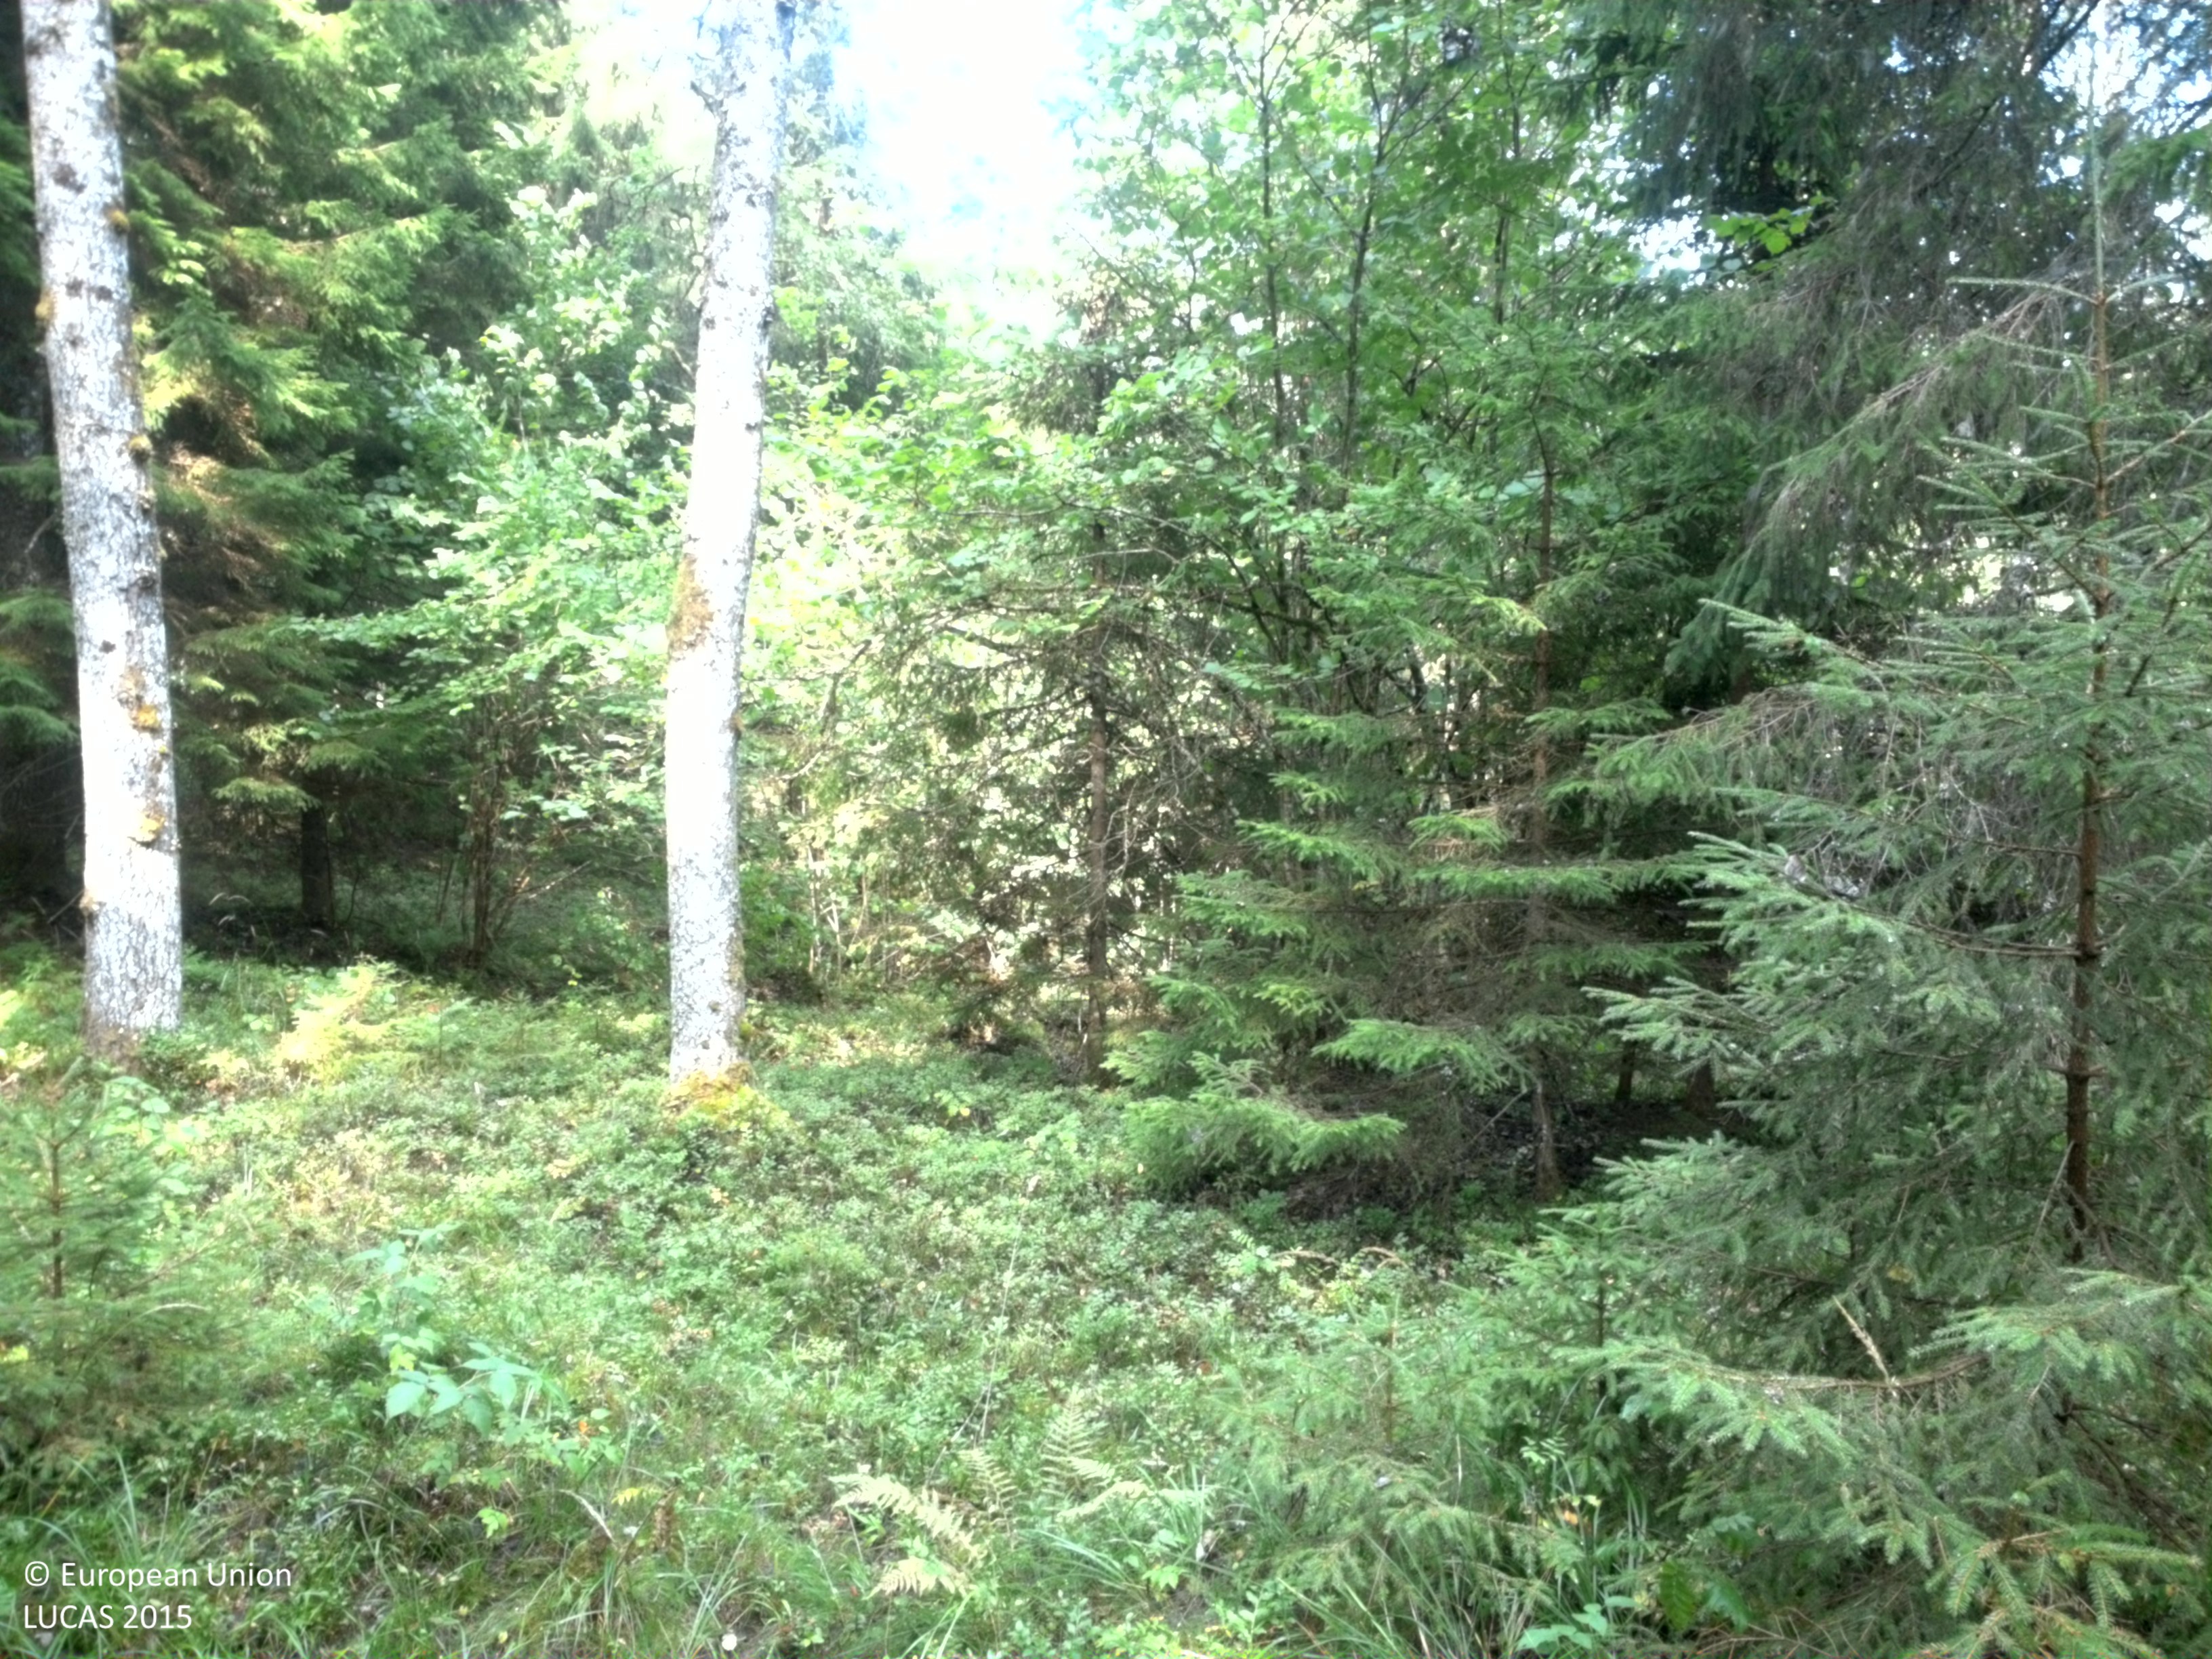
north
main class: Woodland
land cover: Spruce dominated mixed woodland
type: boreal forest
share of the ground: 25 - 50 %
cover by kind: coniferous forest trees 25 %, broadleaved forest trees 25 %, herbaceous plants 20 %, lichens and mosses 20 %, shrubs 10 %
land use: Agriculture (excluding fallow land and kitchen gardens)
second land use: Forestry
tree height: > 5 m
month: August
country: SE
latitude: 57.9450
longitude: 13.9646
